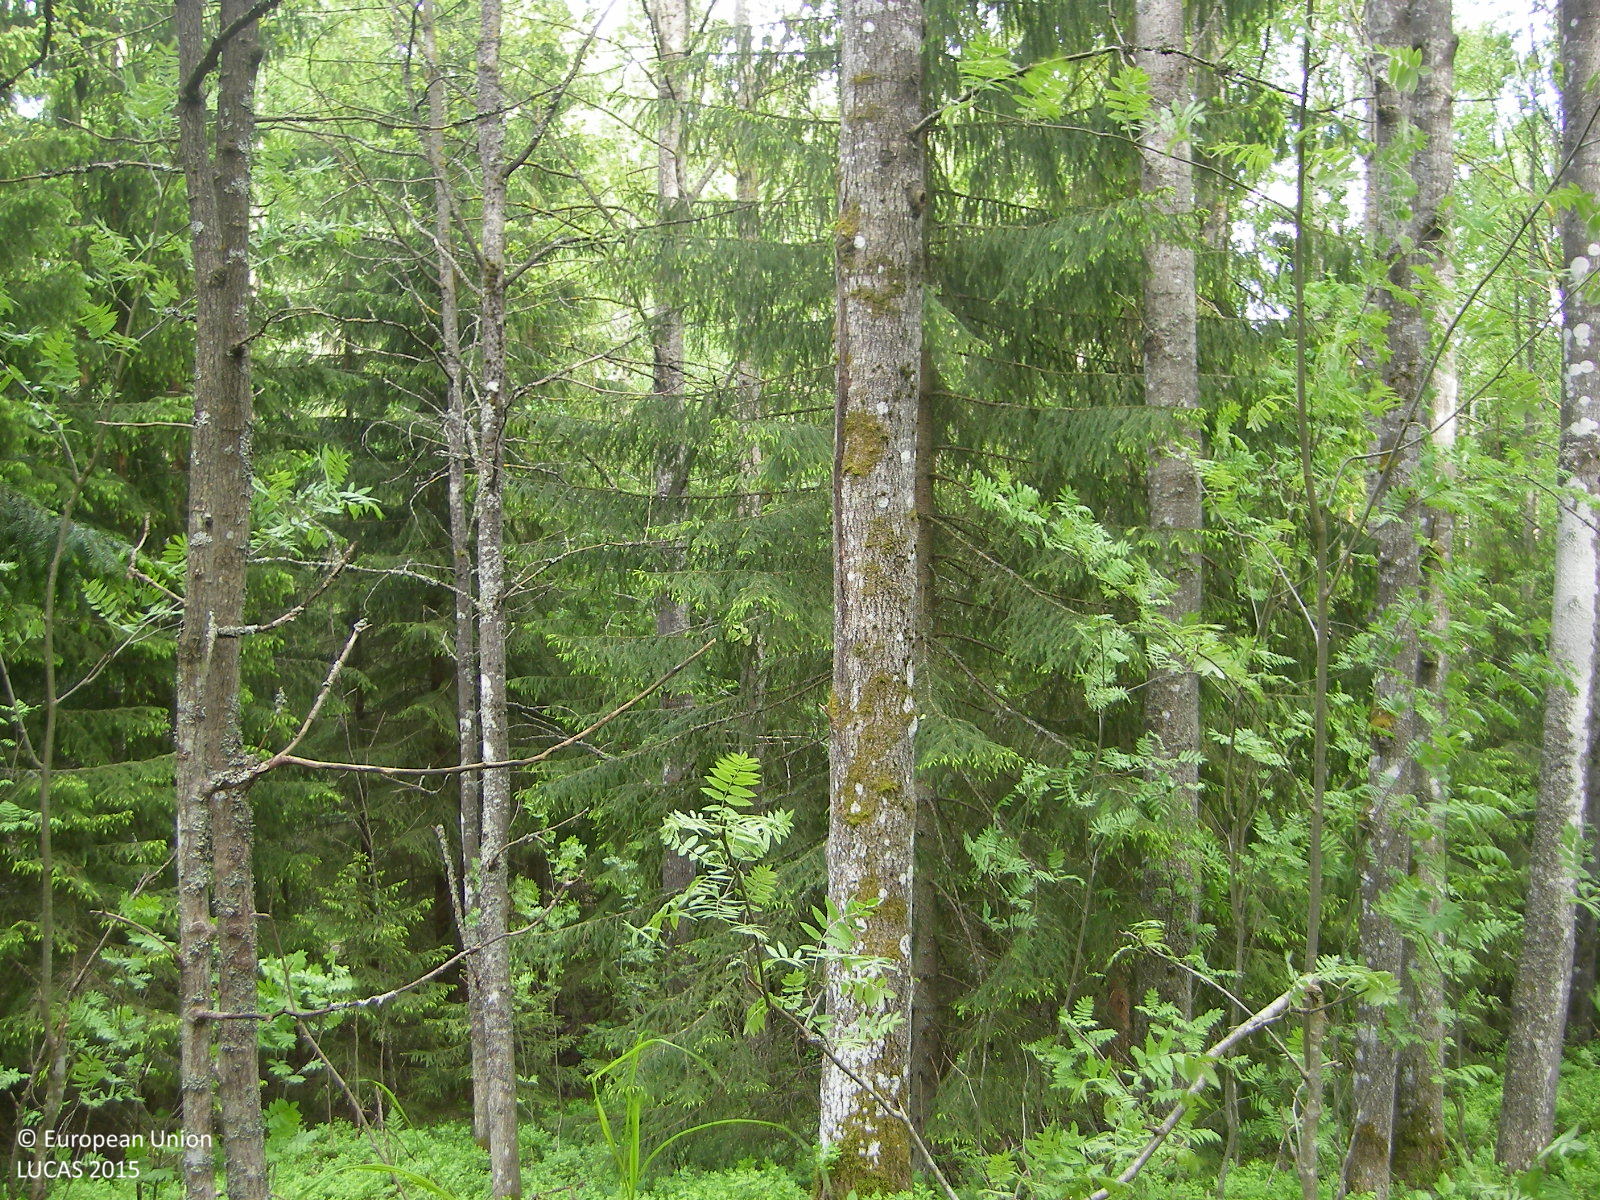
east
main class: Woodland
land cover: Spruce dominated mixed woodland
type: boreal forest
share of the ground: 50 - 75 %
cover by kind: broadleaved forest trees 40 %, coniferous forest trees 30 %, shrubs 15 %, herbaceous plants 10 %, lichens and mosses 5 %
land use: Forestry
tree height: > 5 m
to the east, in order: Spruce dominated mixed woodland; Tracks; Spruce dominated mixed woodland; Tracks; Spruce dominated mixed woodland
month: June
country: FI
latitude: 60.3514
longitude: 24.7746
